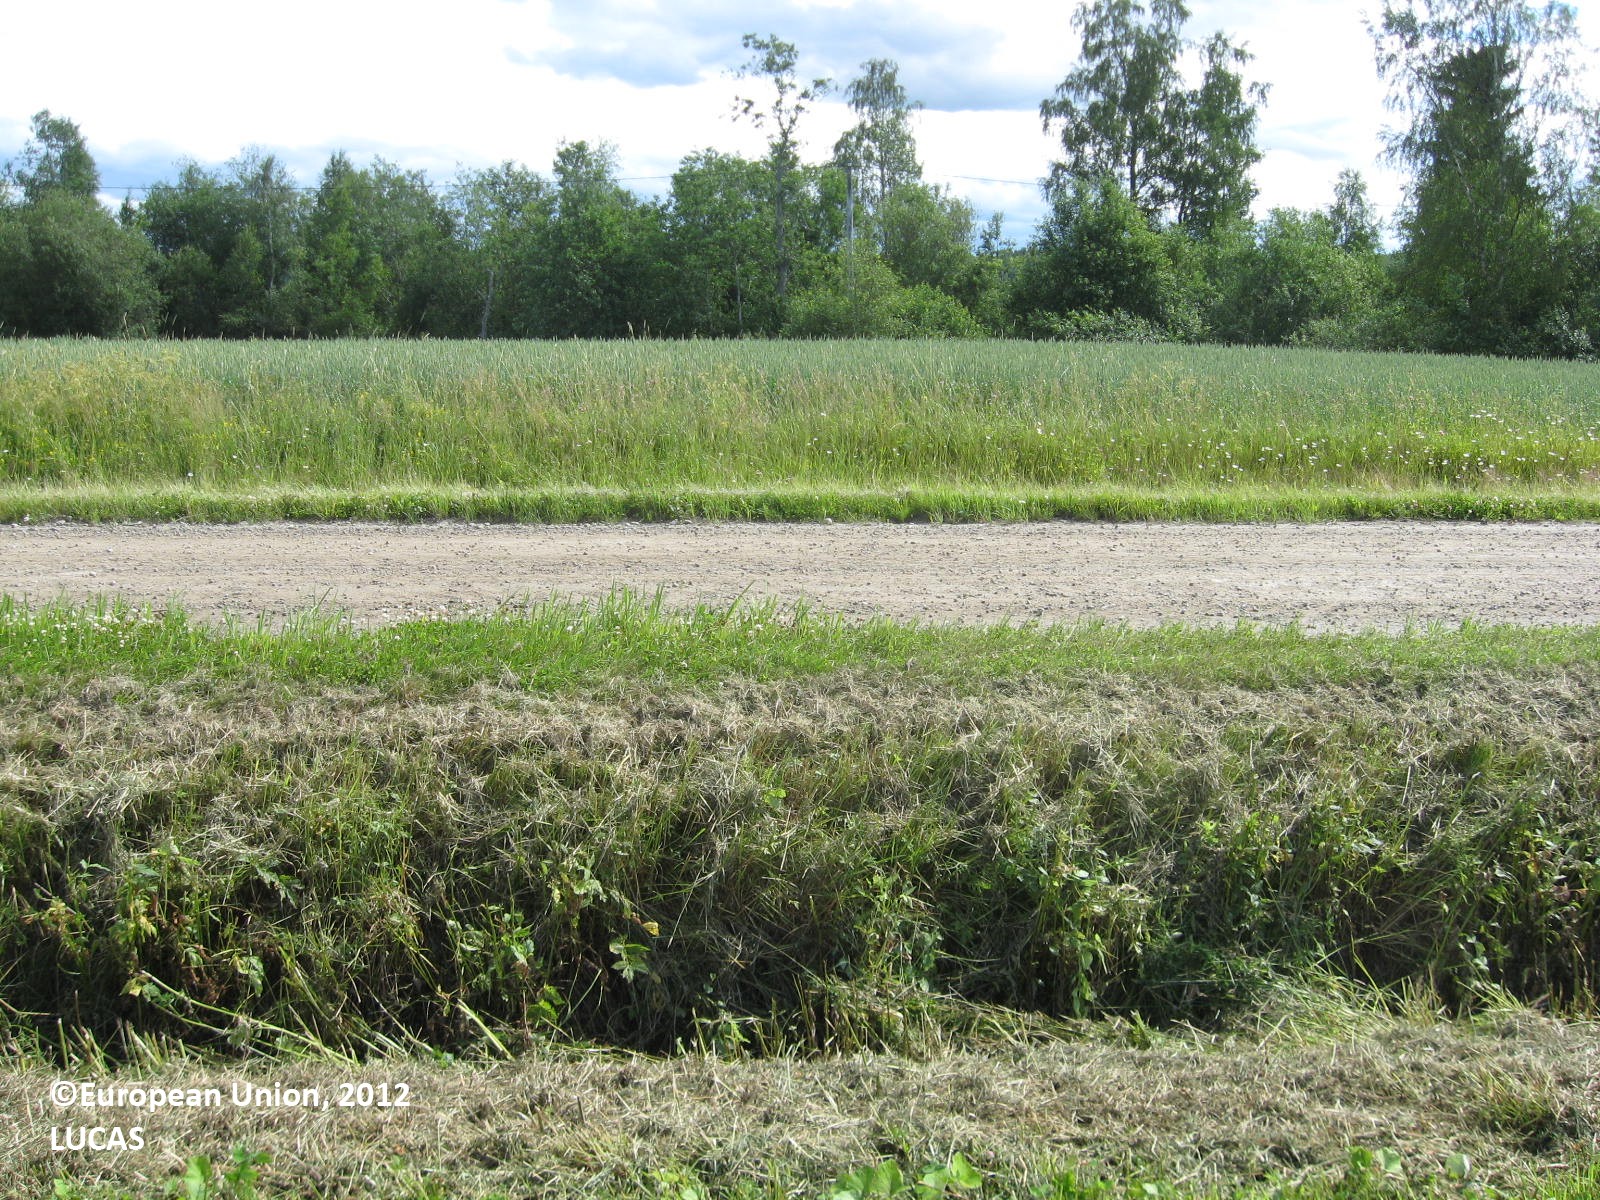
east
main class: Cropland
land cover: Clovers
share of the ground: > 75 %
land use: Agriculture (excluding fallow land and kitchen gardens)
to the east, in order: Clovers; Grass margins; Ditches and canals; Grass margins; Paved roads, cycling and walking lanes; Grass margins; Ditches and canals; Shruby margins; Common wheat; Grassland without tree/shrub cover; Electric lines; Broadleaved woodland; Rivers and streams; Broadleaved woodland; Shruby margins; Grass margins; Temporary grasslands
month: July
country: FI
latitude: 62.3292
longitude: 21.5689
